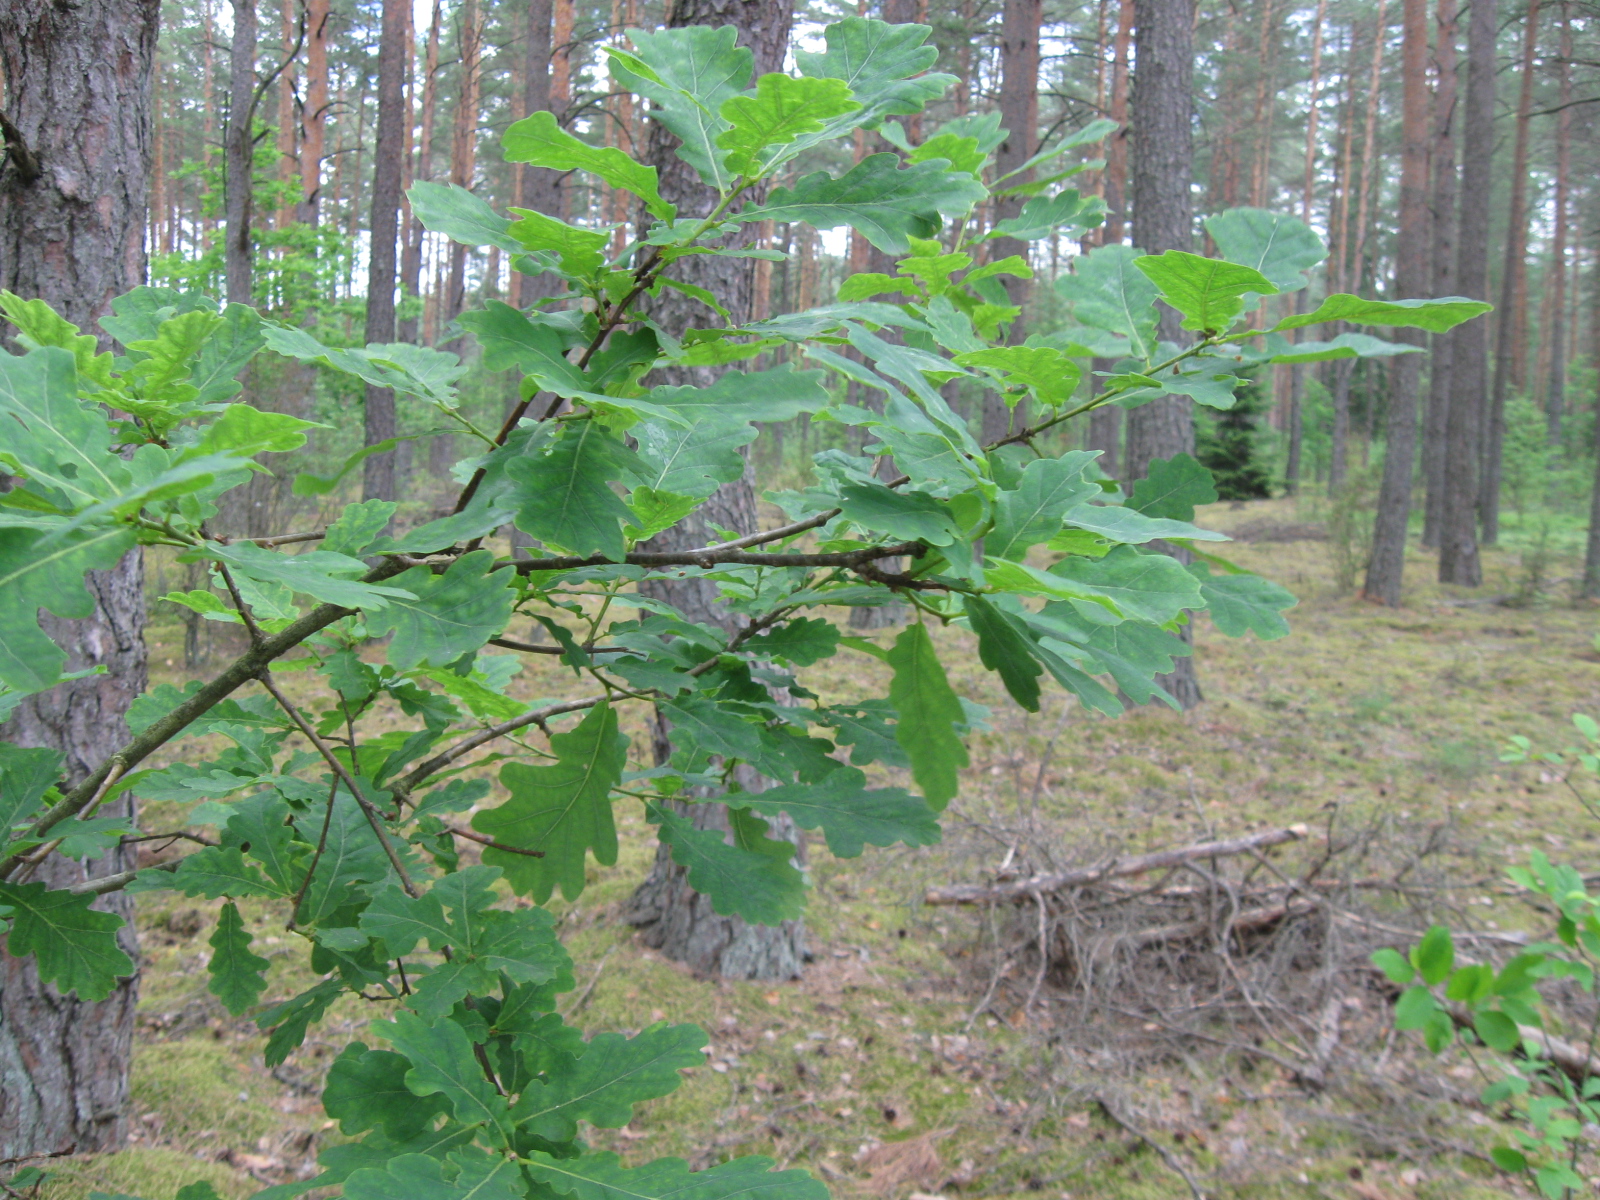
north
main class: Woodland
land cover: Pine dominated mixed woodland
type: hemiboreal forest and nemoral coniferous forest and mixed broadleaved-coniferous forest
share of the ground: > 75 %
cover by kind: coniferous forest trees 45 %, broadleaved forest trees 30 %, lichens and mosses 25 %
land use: Forestry
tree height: > 5 m
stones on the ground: < 10 %
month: July
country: LT
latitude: 54.1915
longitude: 24.3067
